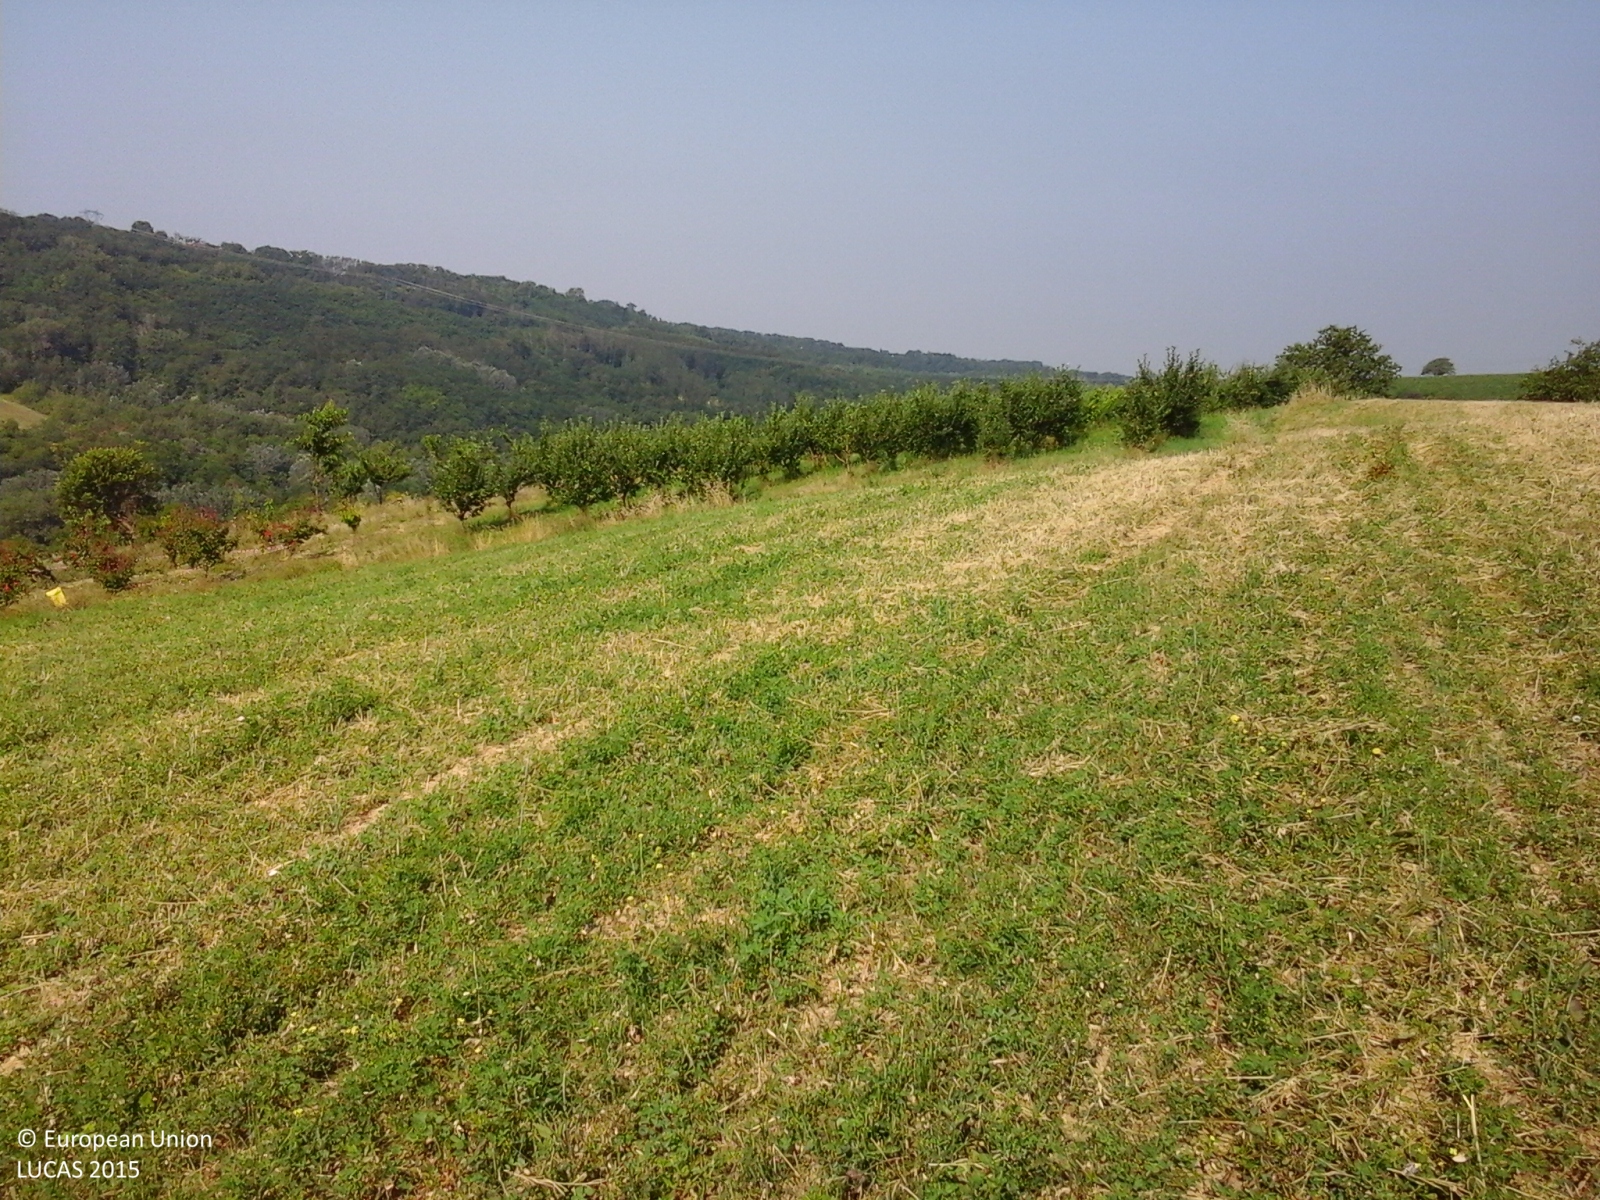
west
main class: Cropland
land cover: Temporary grasslands
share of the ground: > 75 %
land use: Agriculture (excluding fallow land and kitchen gardens)
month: June
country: IT
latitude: 44.7959
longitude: 8.9277
